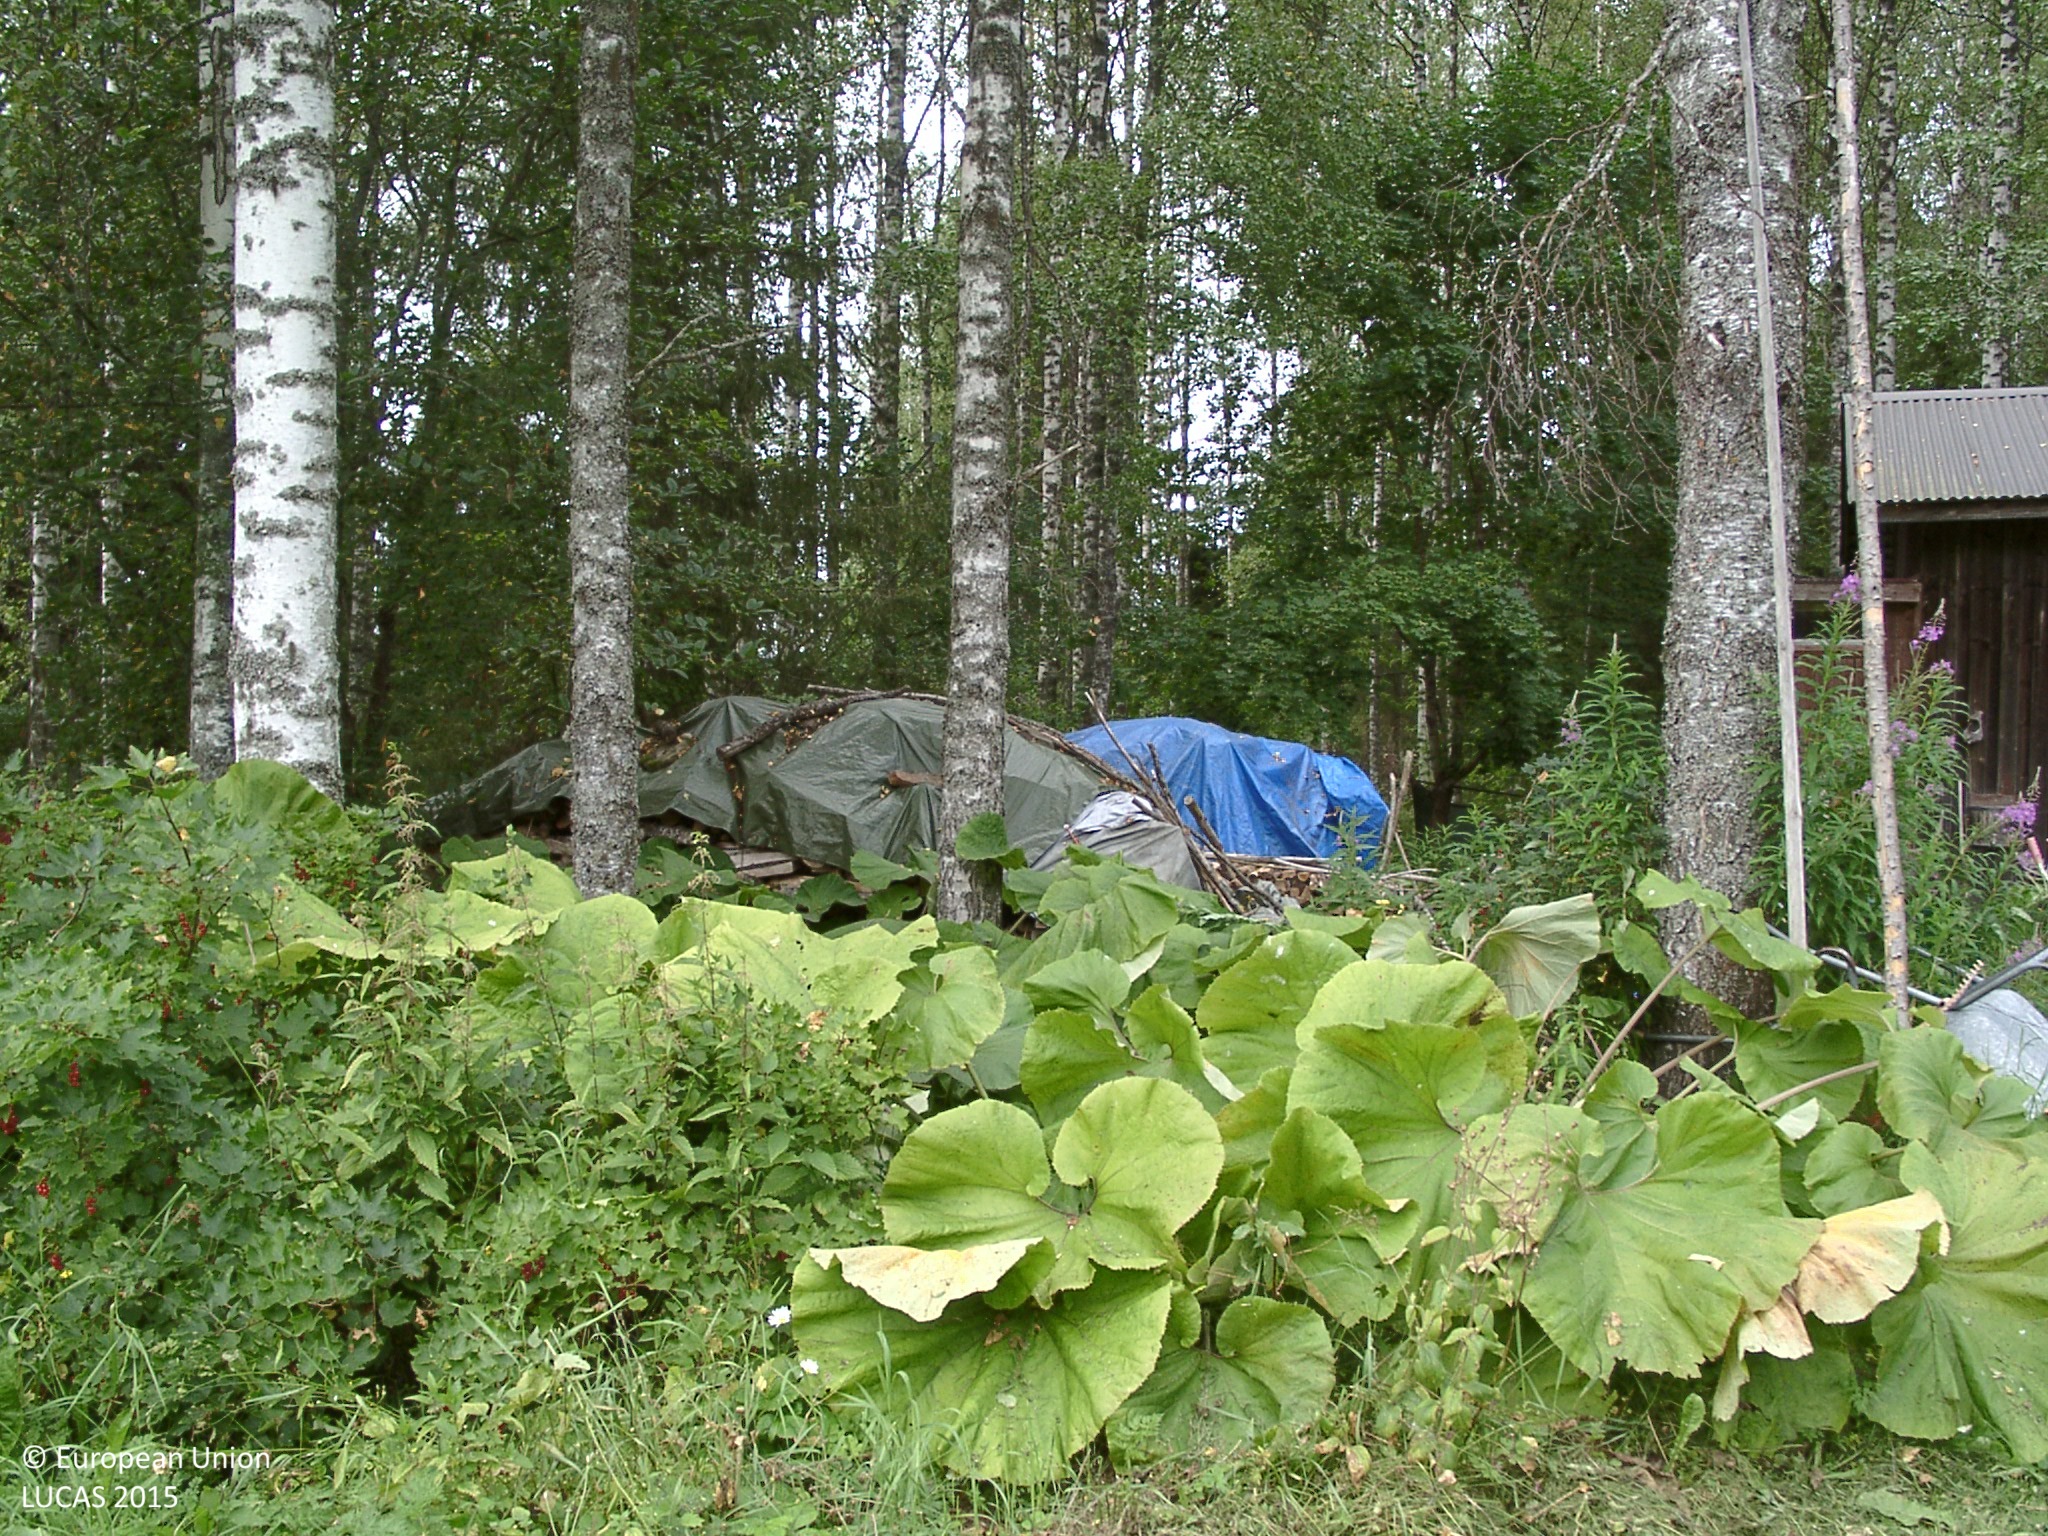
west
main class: Grassland
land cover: Grassland without tree/shrub cover
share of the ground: > 75 %
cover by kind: herbaceous plants 75 %, lichens and mosses 25 %
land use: Residential
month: August
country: FI
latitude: 62.4286
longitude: 25.5089
